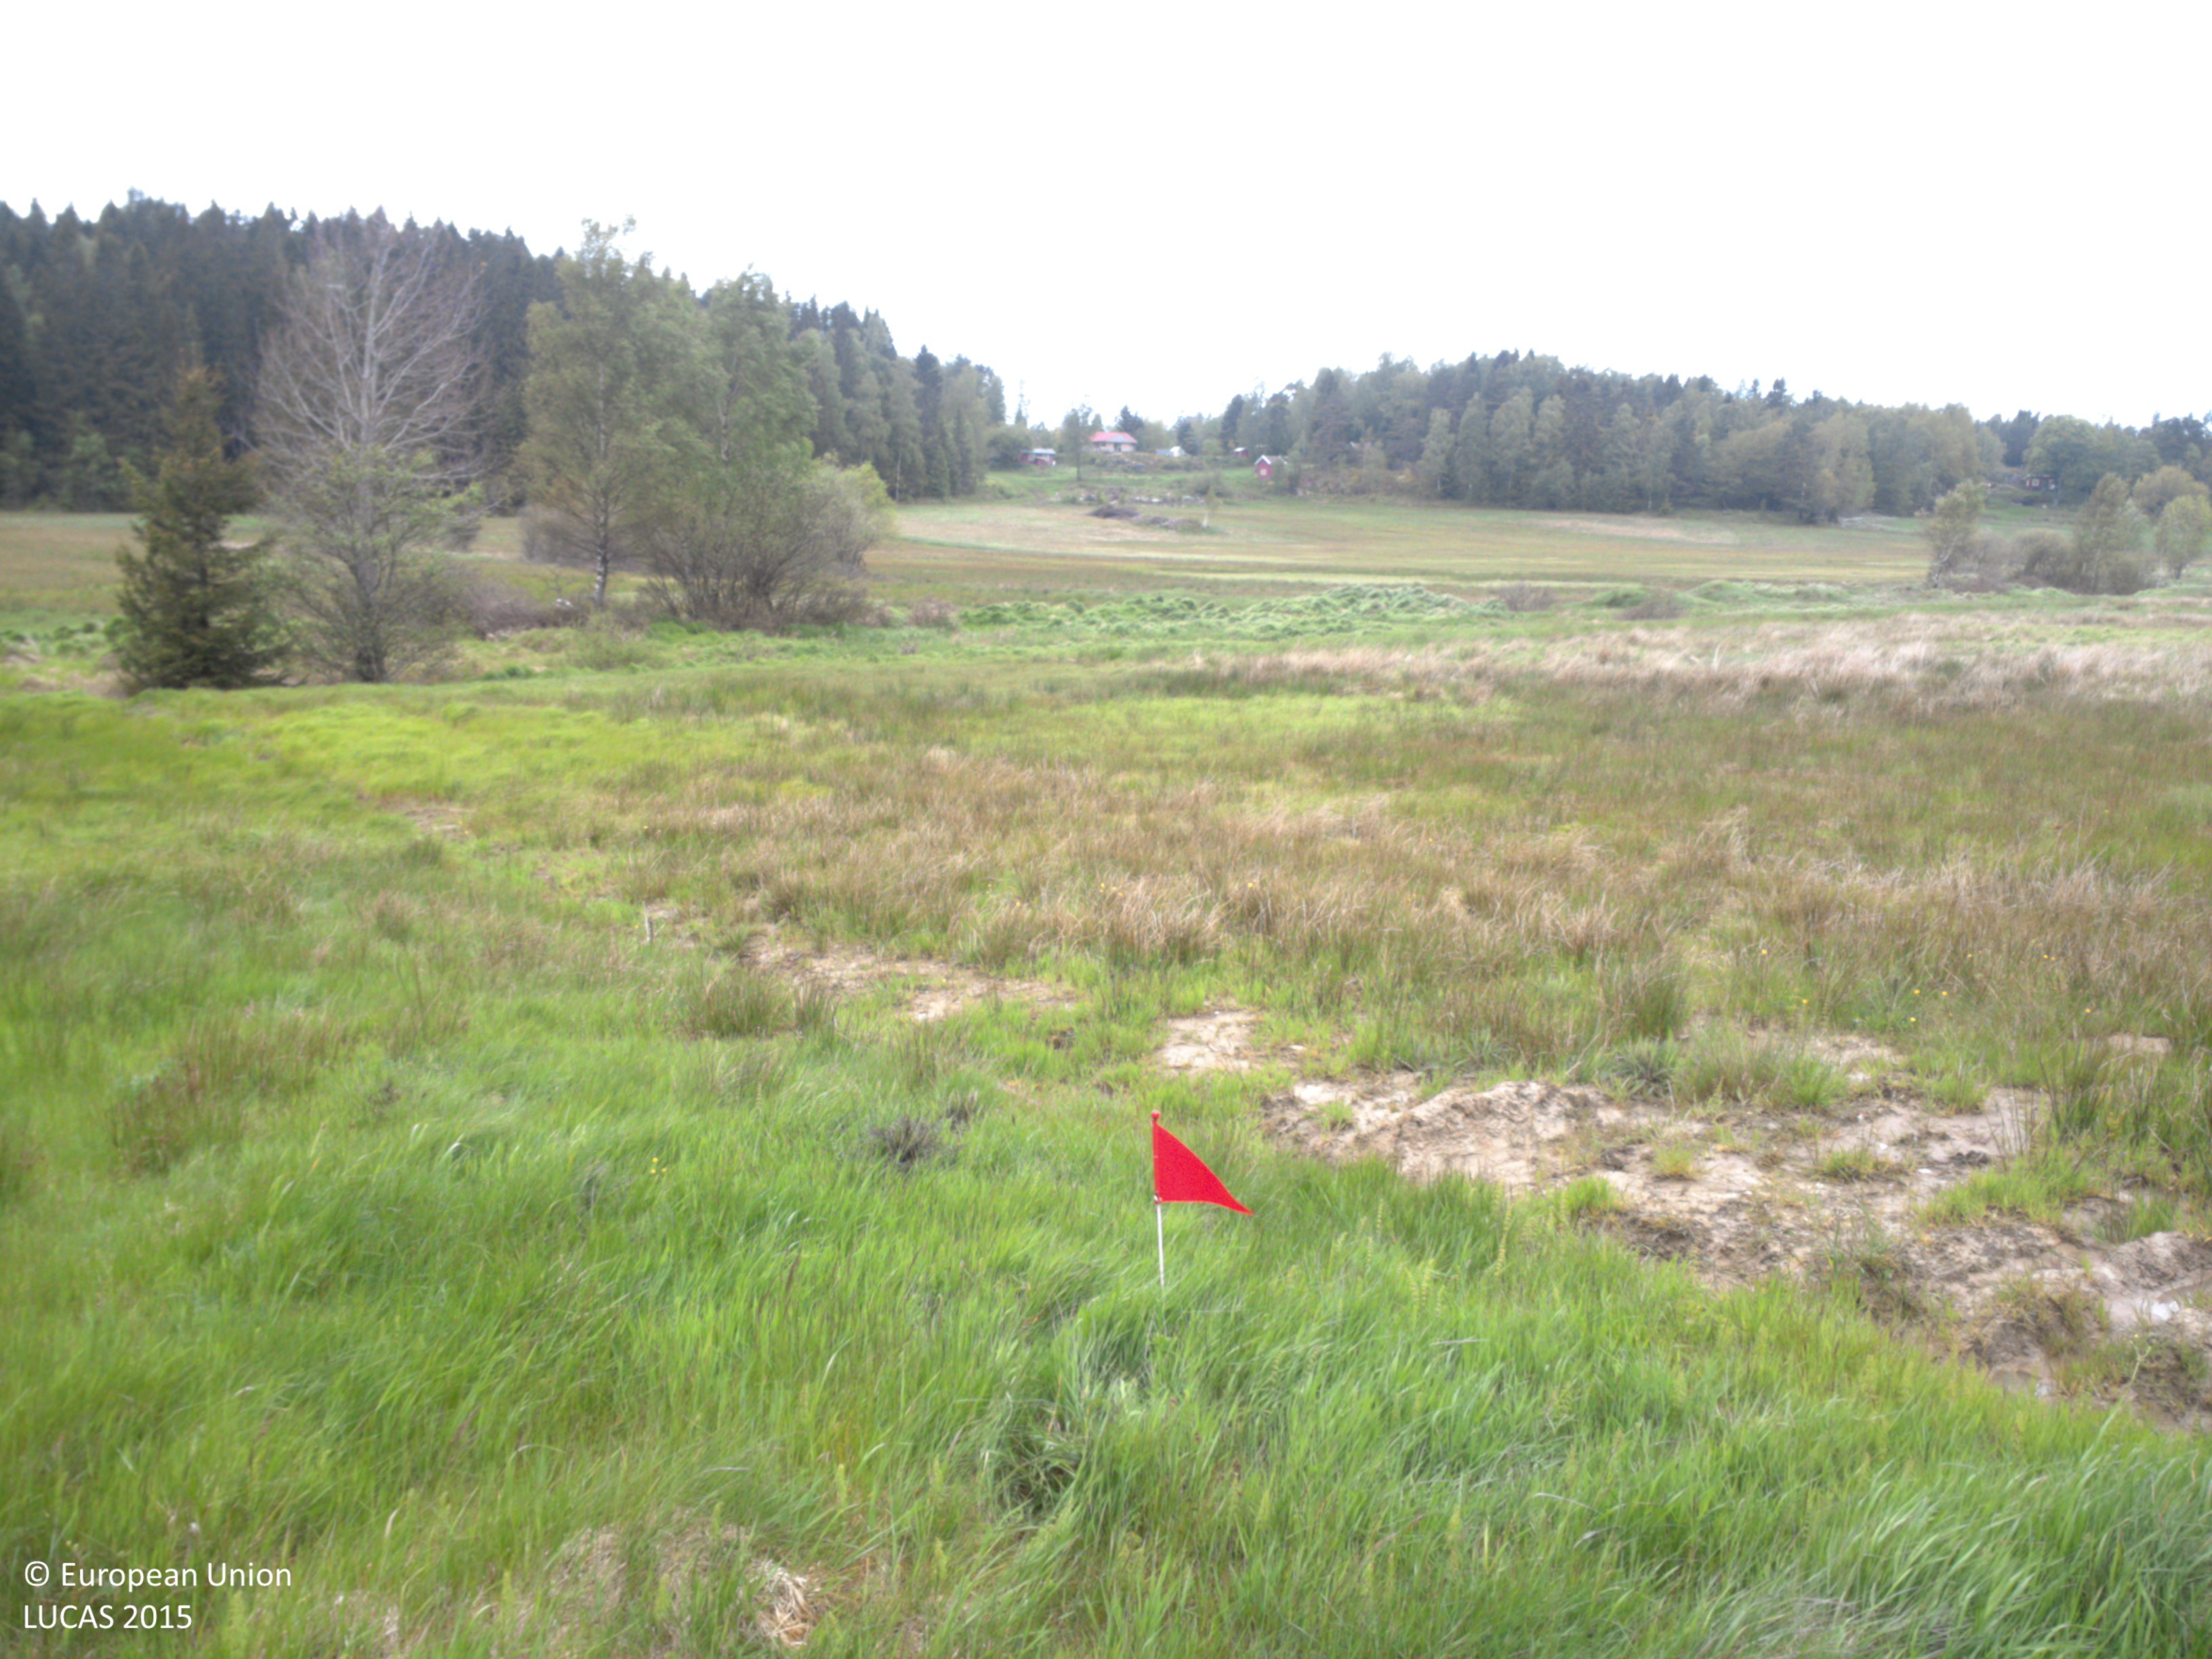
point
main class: Grassland
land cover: Grassland without tree/shrub cover
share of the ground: > 75 %
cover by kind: herbaceous plants 100 %
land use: Agriculture (excluding fallow land and kitchen gardens)
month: June
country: SE
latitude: 58.1693
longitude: 11.9512
